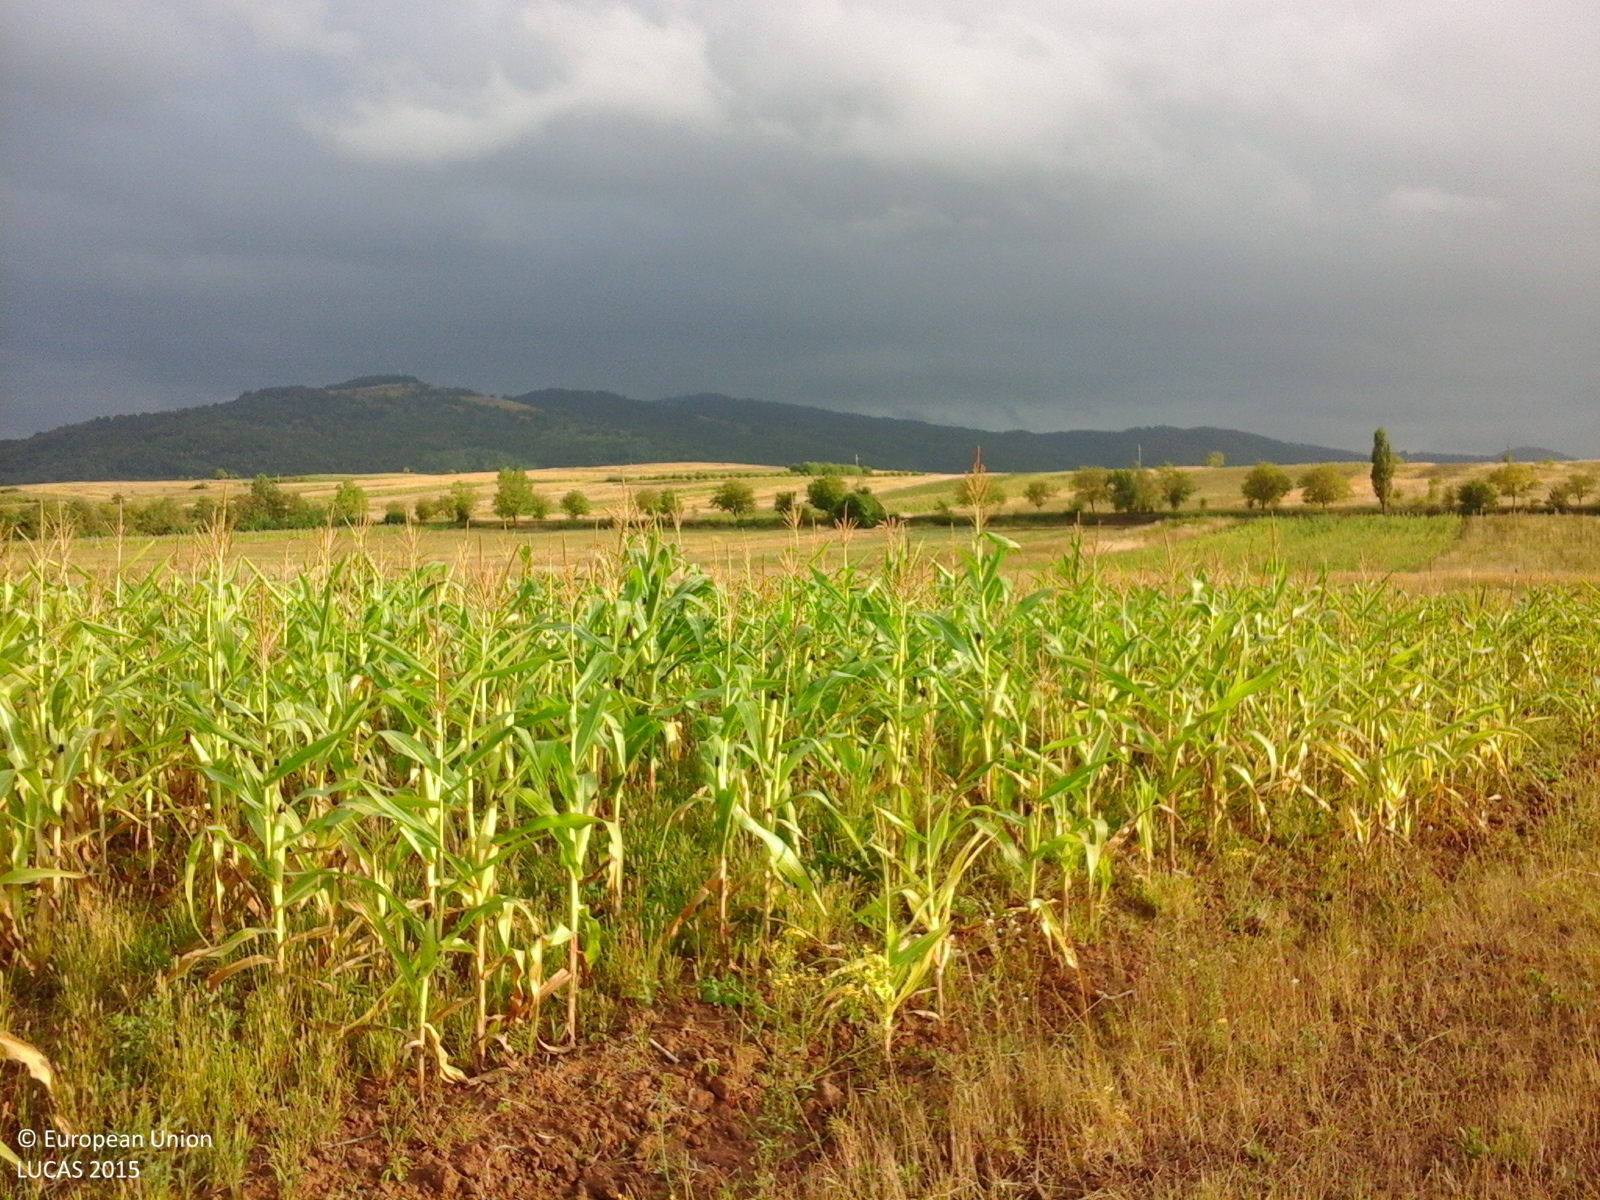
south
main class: Grassland
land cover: Grassland without tree/shrub cover
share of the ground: > 75 %
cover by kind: herbaceous plants 100 %
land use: Agriculture (excluding fallow land and kitchen gardens)
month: August
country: RO
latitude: 44.8752
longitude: 21.9709
